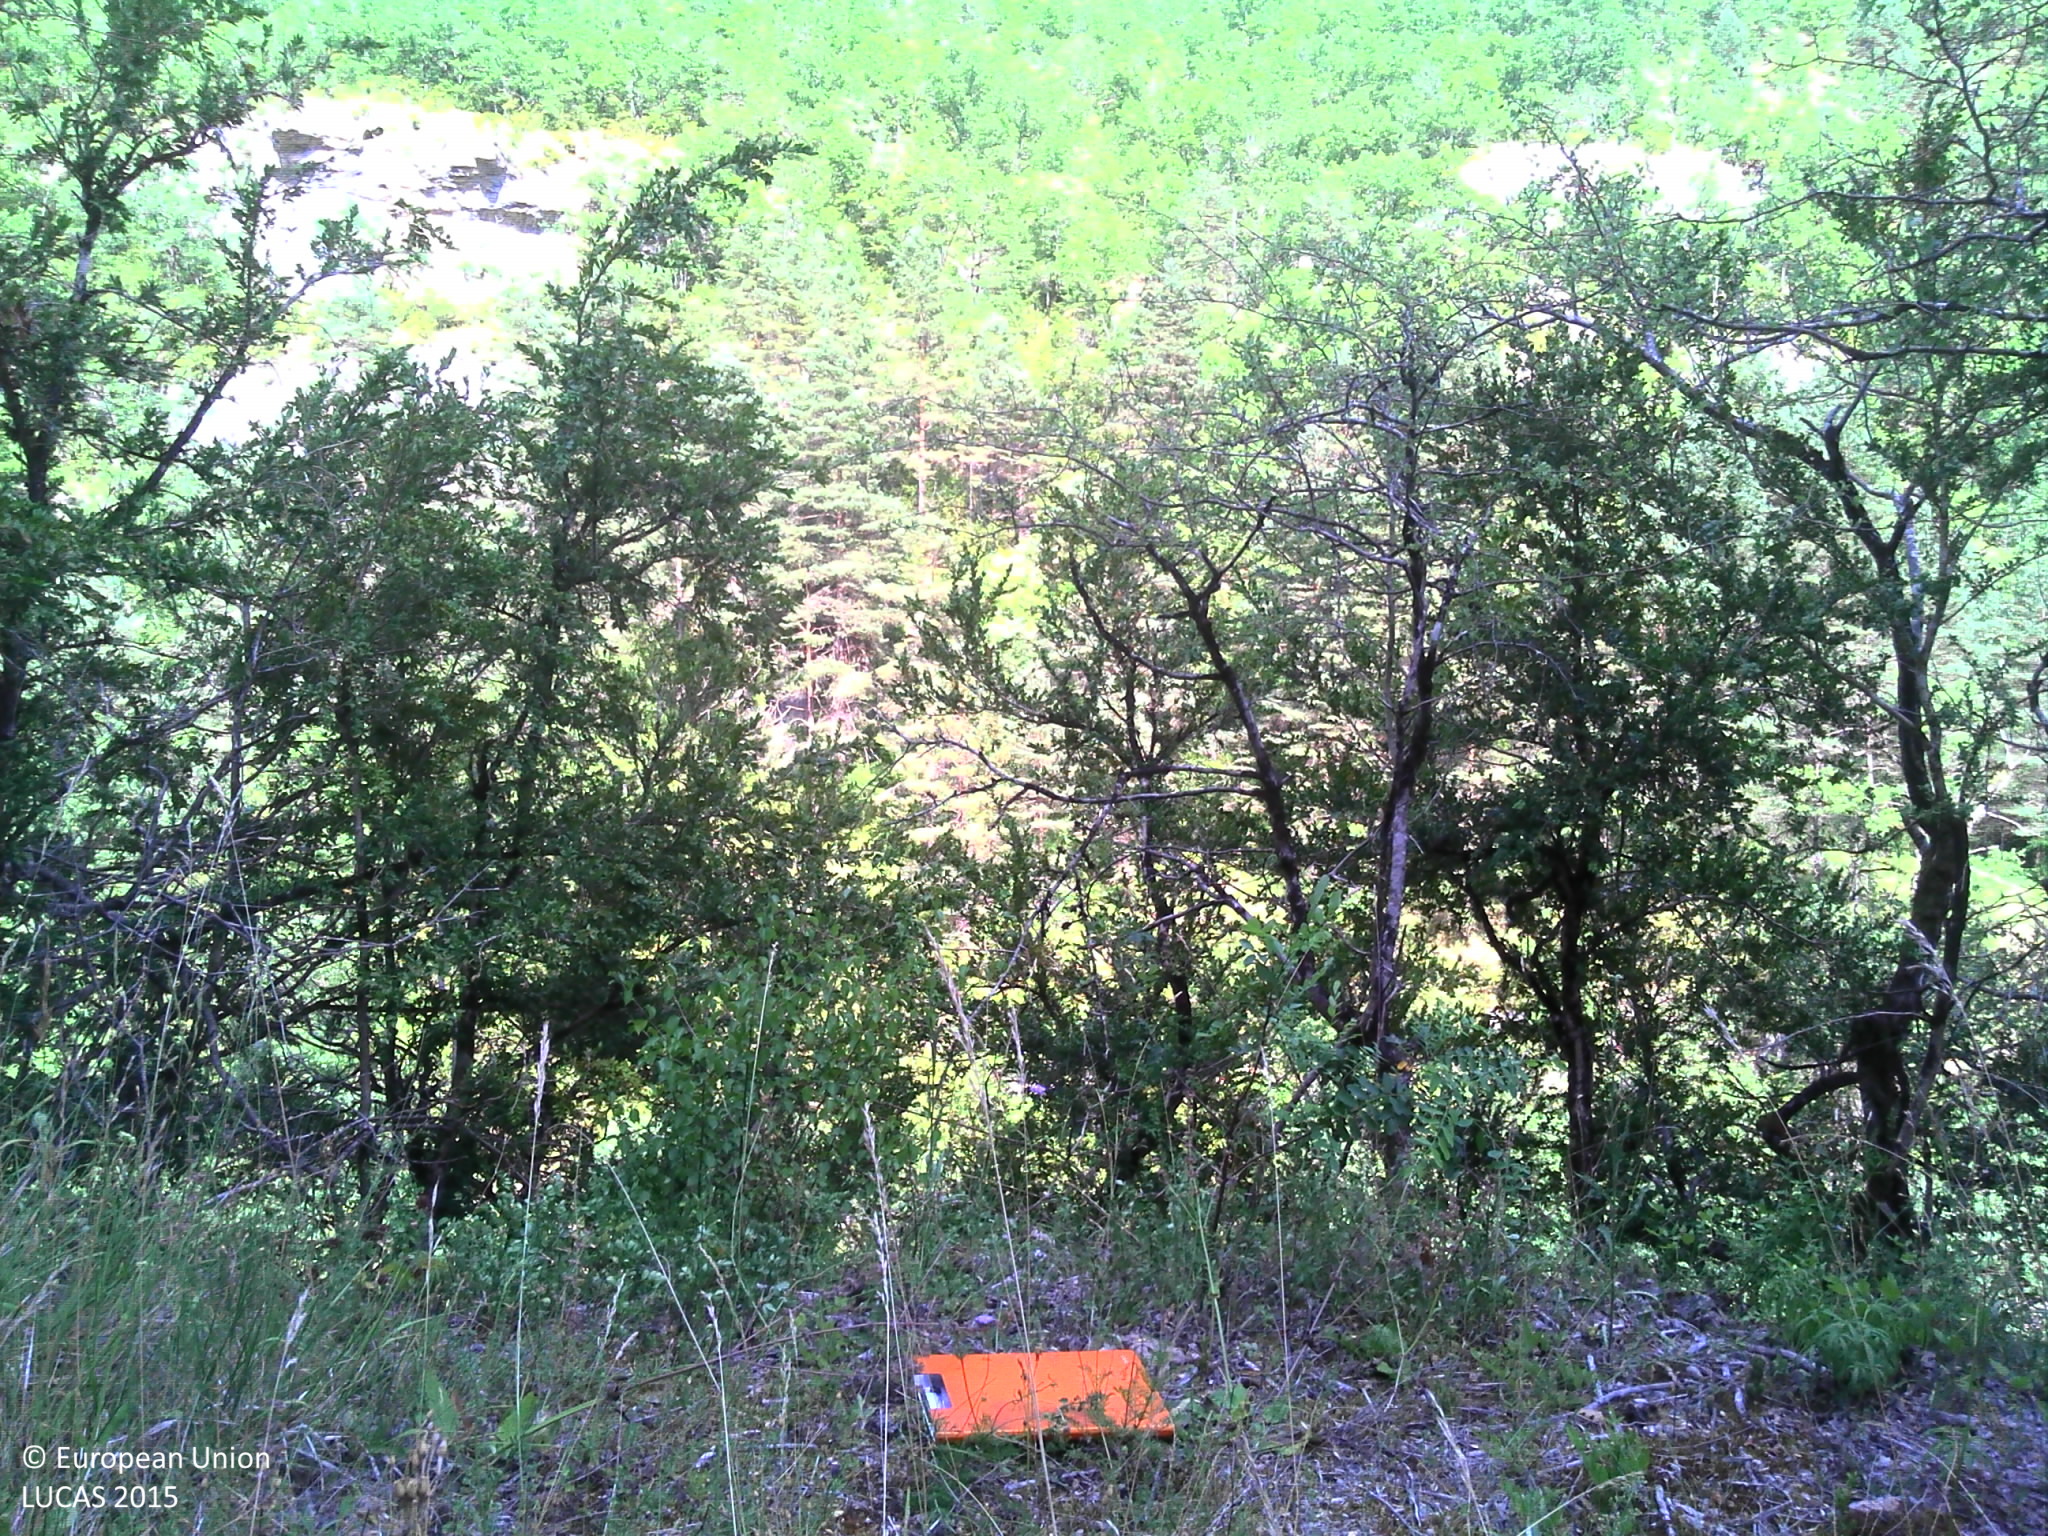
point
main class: Woodland
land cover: Pine dominated mixed woodland
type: hemiboreal forest and nemoral coniferous forest and mixed broadleaved-coniferous forest
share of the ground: > 75 %
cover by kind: broadleaved forest trees 75 %, coniferous forest trees 25 %
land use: Forestry
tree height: > 5 m
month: July
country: FR
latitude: 44.2381
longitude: 3.2318
